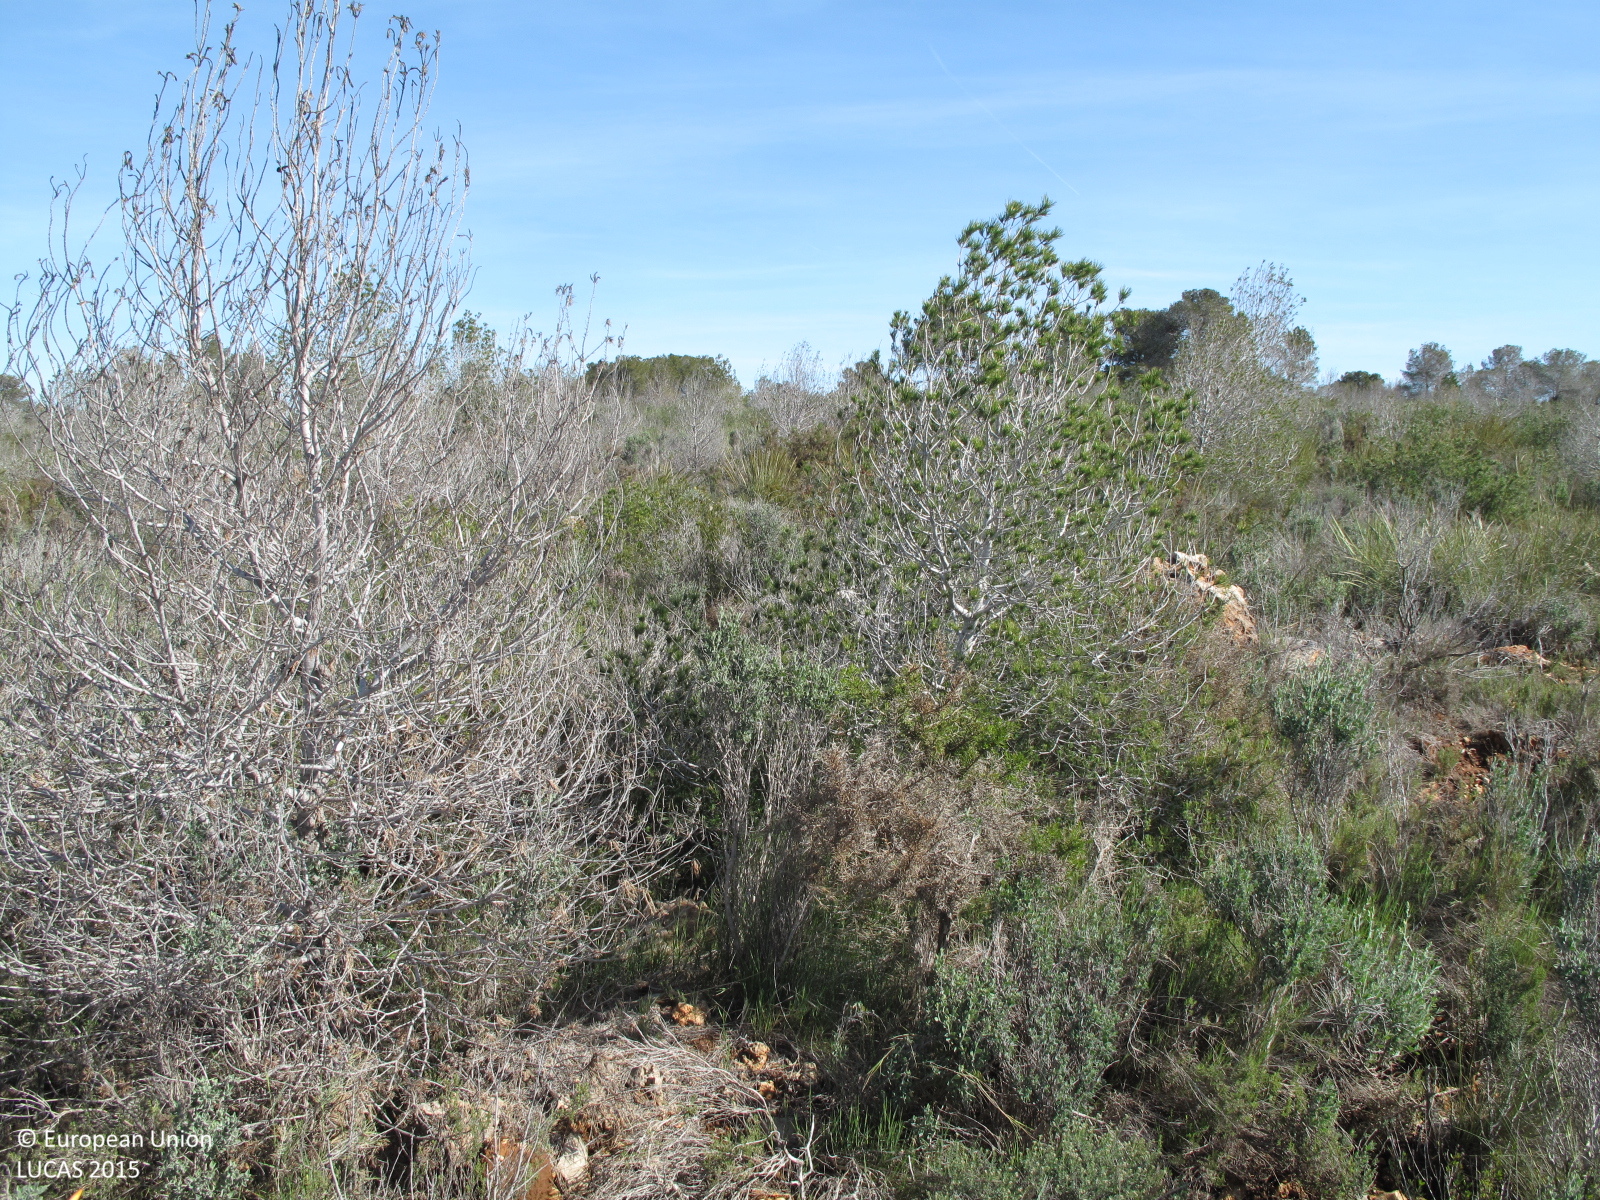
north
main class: Shrubland
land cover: Shrubland with sparse tree cover
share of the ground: > 75 %
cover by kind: shrubs 85 %, herbaceous plants 10 %, coniferous forest trees 5 %
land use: Semi-natural and natural areas not in use
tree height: < 5 m
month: March
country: ES
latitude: 39.1412
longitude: -0.6274
